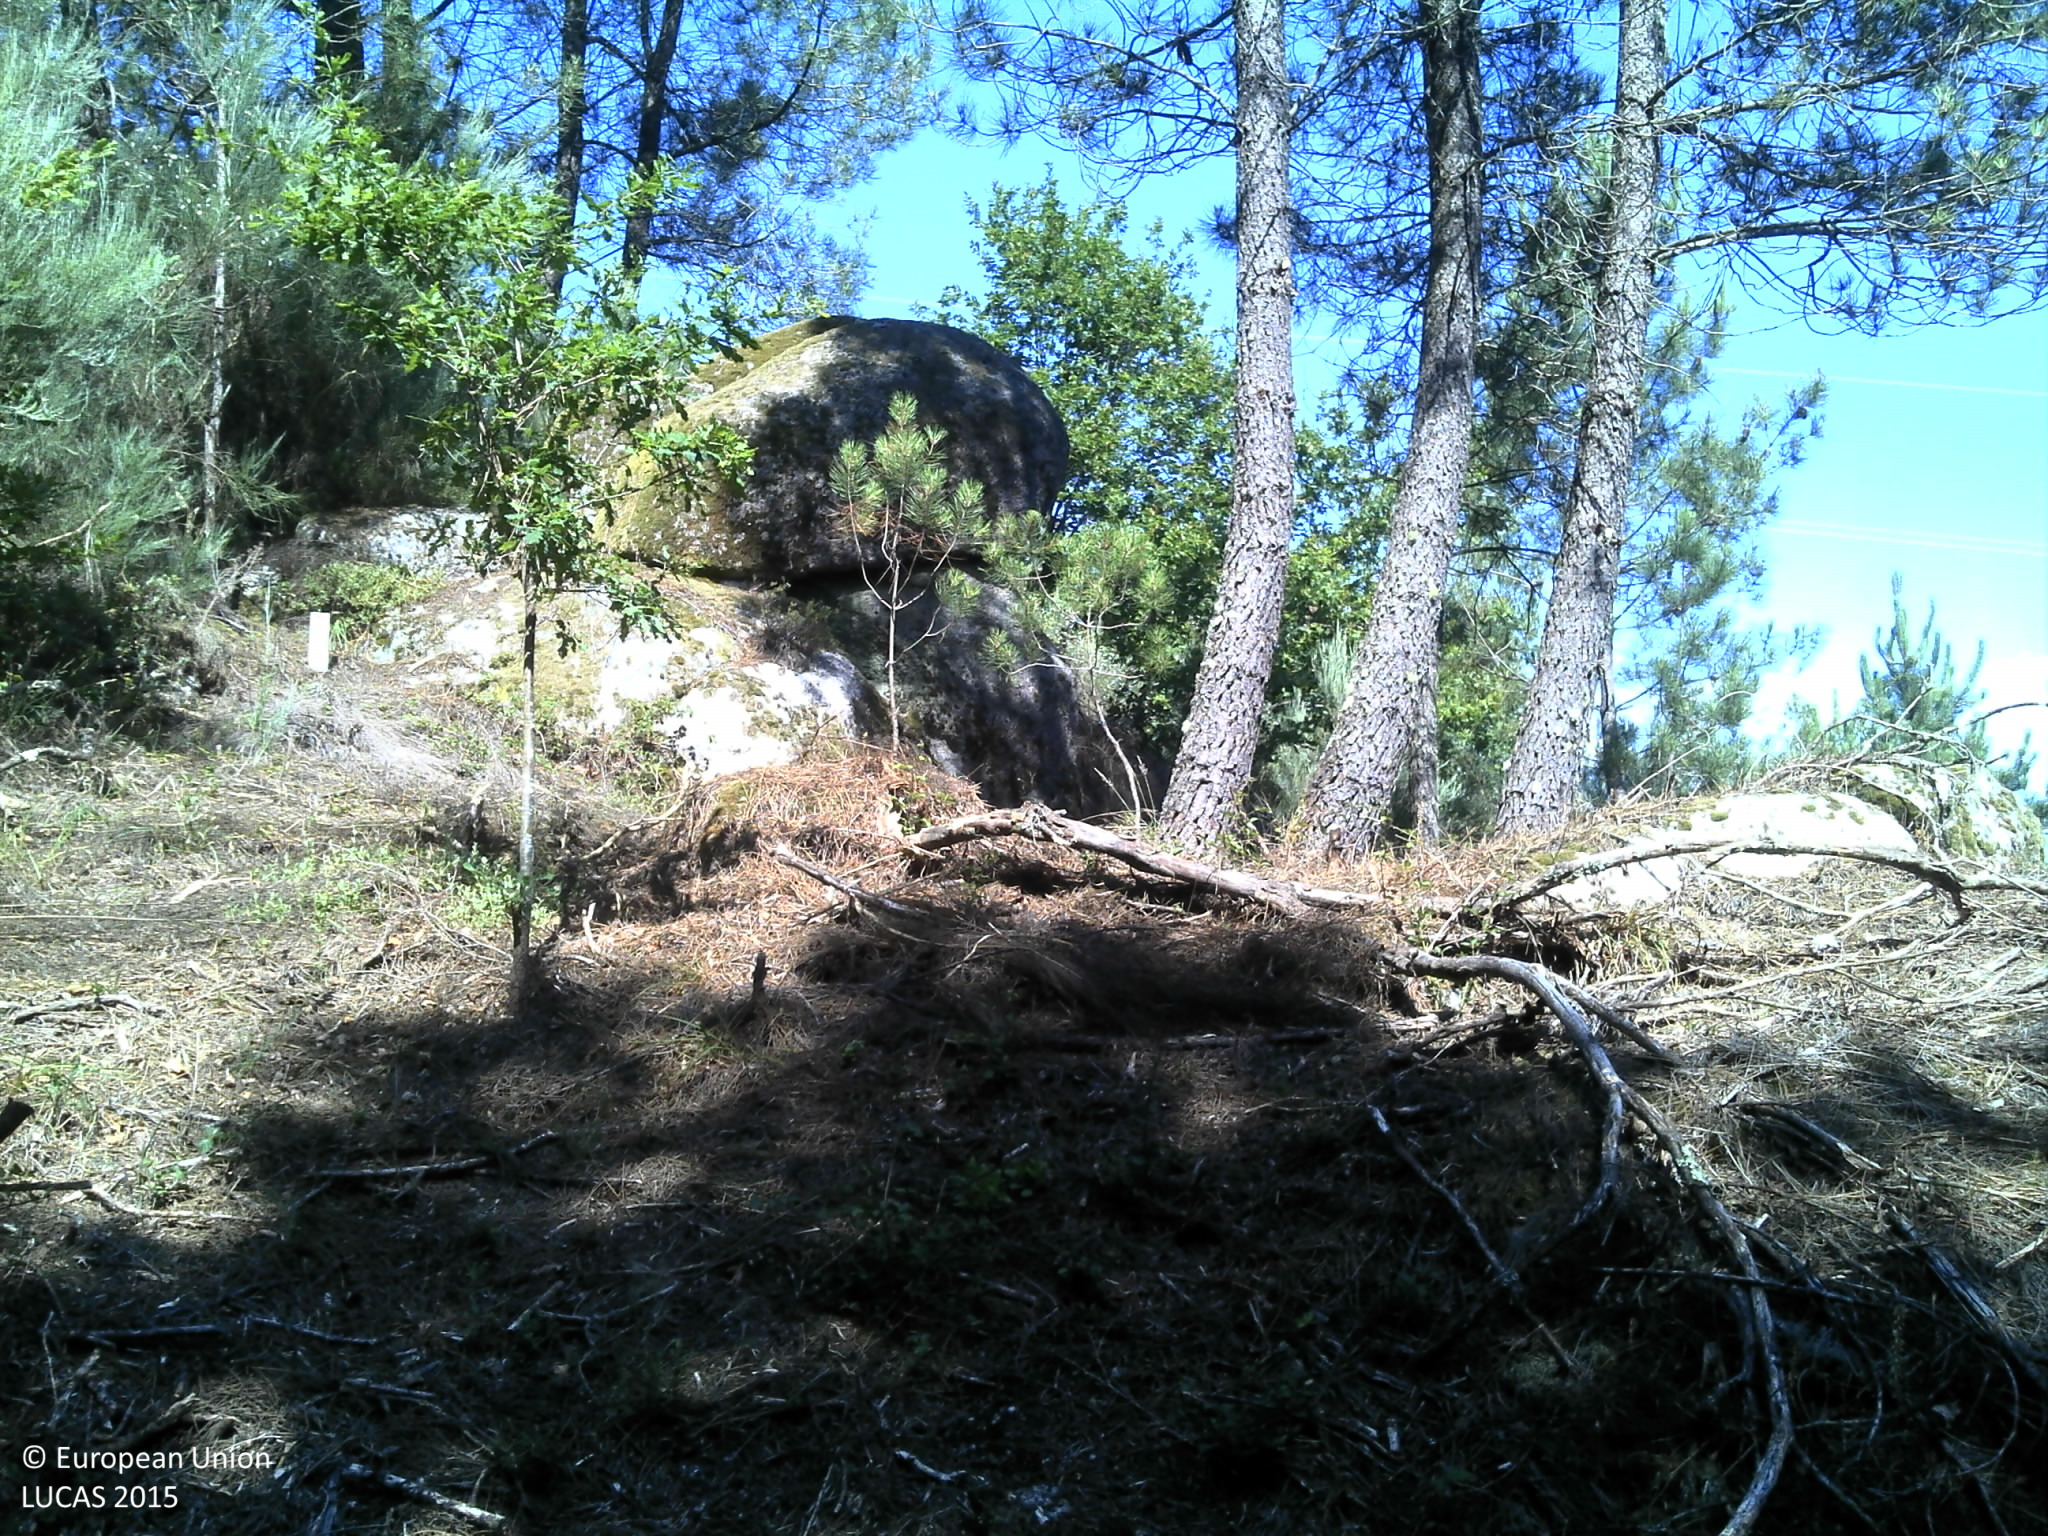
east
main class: Woodland
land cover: Pine dominated coniferous woodland
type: coniferous forest of the mediterranean region
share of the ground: 25 - 50 %
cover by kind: coniferous forest trees 50 %, shrubs 30 %, consolidated bare surface 10 %, herbaceous plants 5 %, unconsolidated bare surface 5 %
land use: Forestry
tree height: > 5 m
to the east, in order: Pine dominated coniferous woodland; Rock outcrops; Shrubland with sparse tree cover; Broadleaved woodland; Electric lines; Broadleaved woodland; Pine dominated coniferous woodland; Tracks; Shrubland without tree cover; Shrubland with sparse tree cover; Broadleaved woodland; Pine dominated coniferous woodland; Broadleaved woodland; Rock outcrops; Shrubland with sparse tree cover; Broadleaved woodland
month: June
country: PT
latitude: 40.8622
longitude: -7.9849
